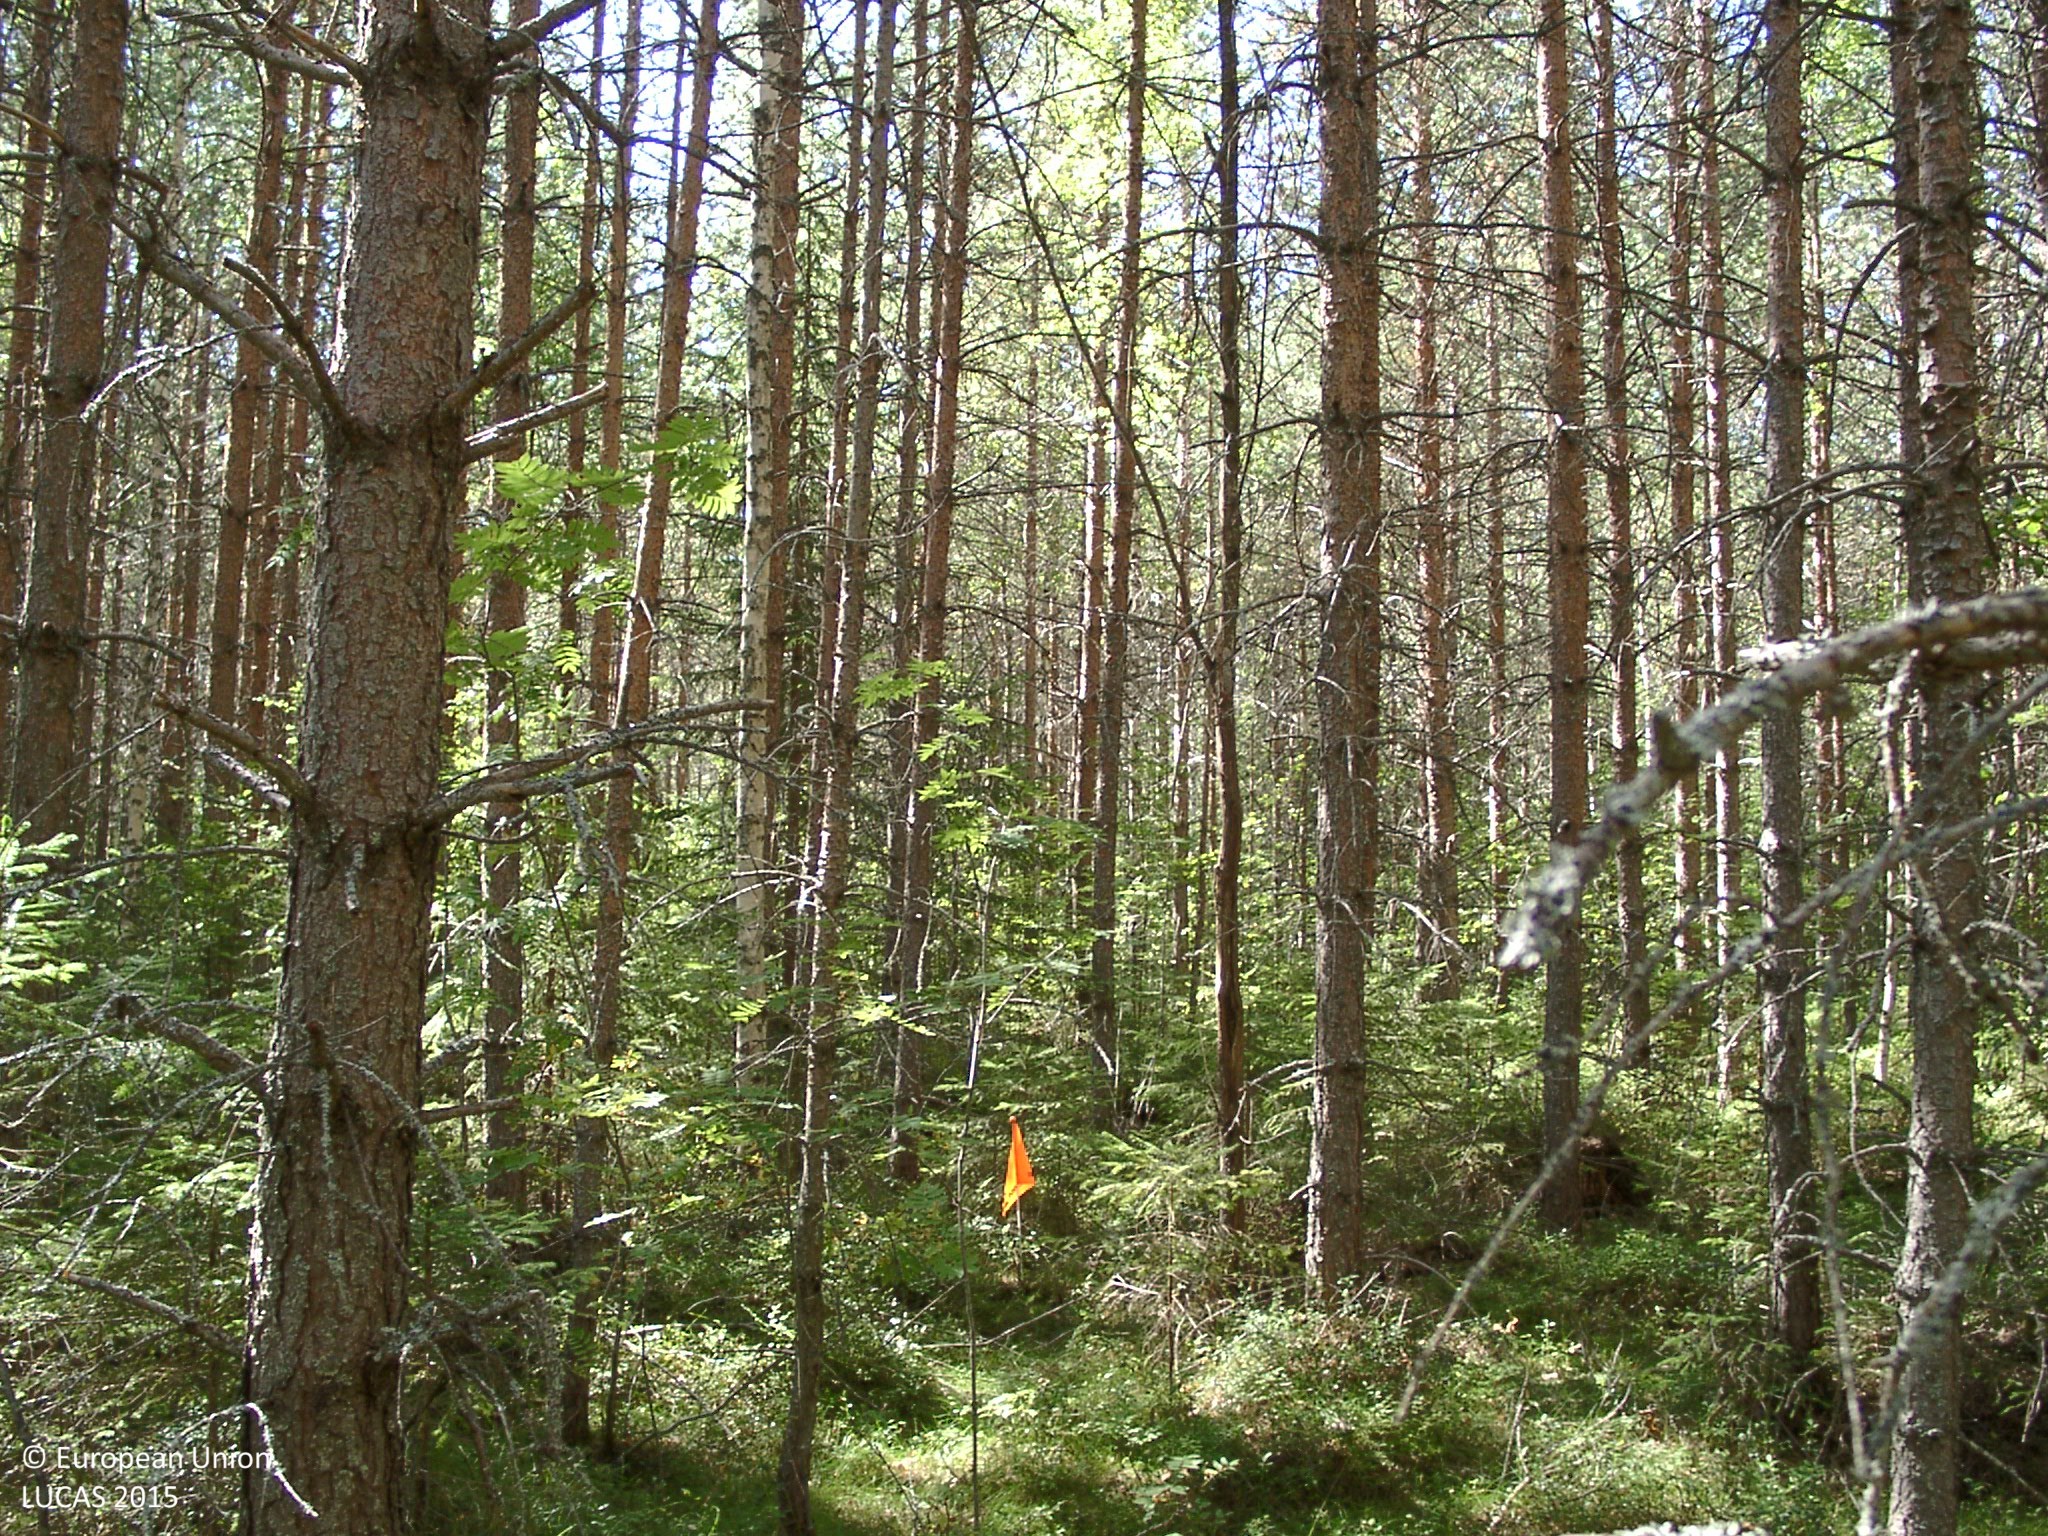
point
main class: Woodland
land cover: Pine dominated coniferous woodland
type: boreal forest
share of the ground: > 75 %
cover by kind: coniferous forest trees 75 %, broadleaved forest trees 10 %, shrubs 10 %, herbaceous plants 5 %
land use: Forestry
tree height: > 5 m
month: August
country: FI
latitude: 62.4423
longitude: 25.1985
